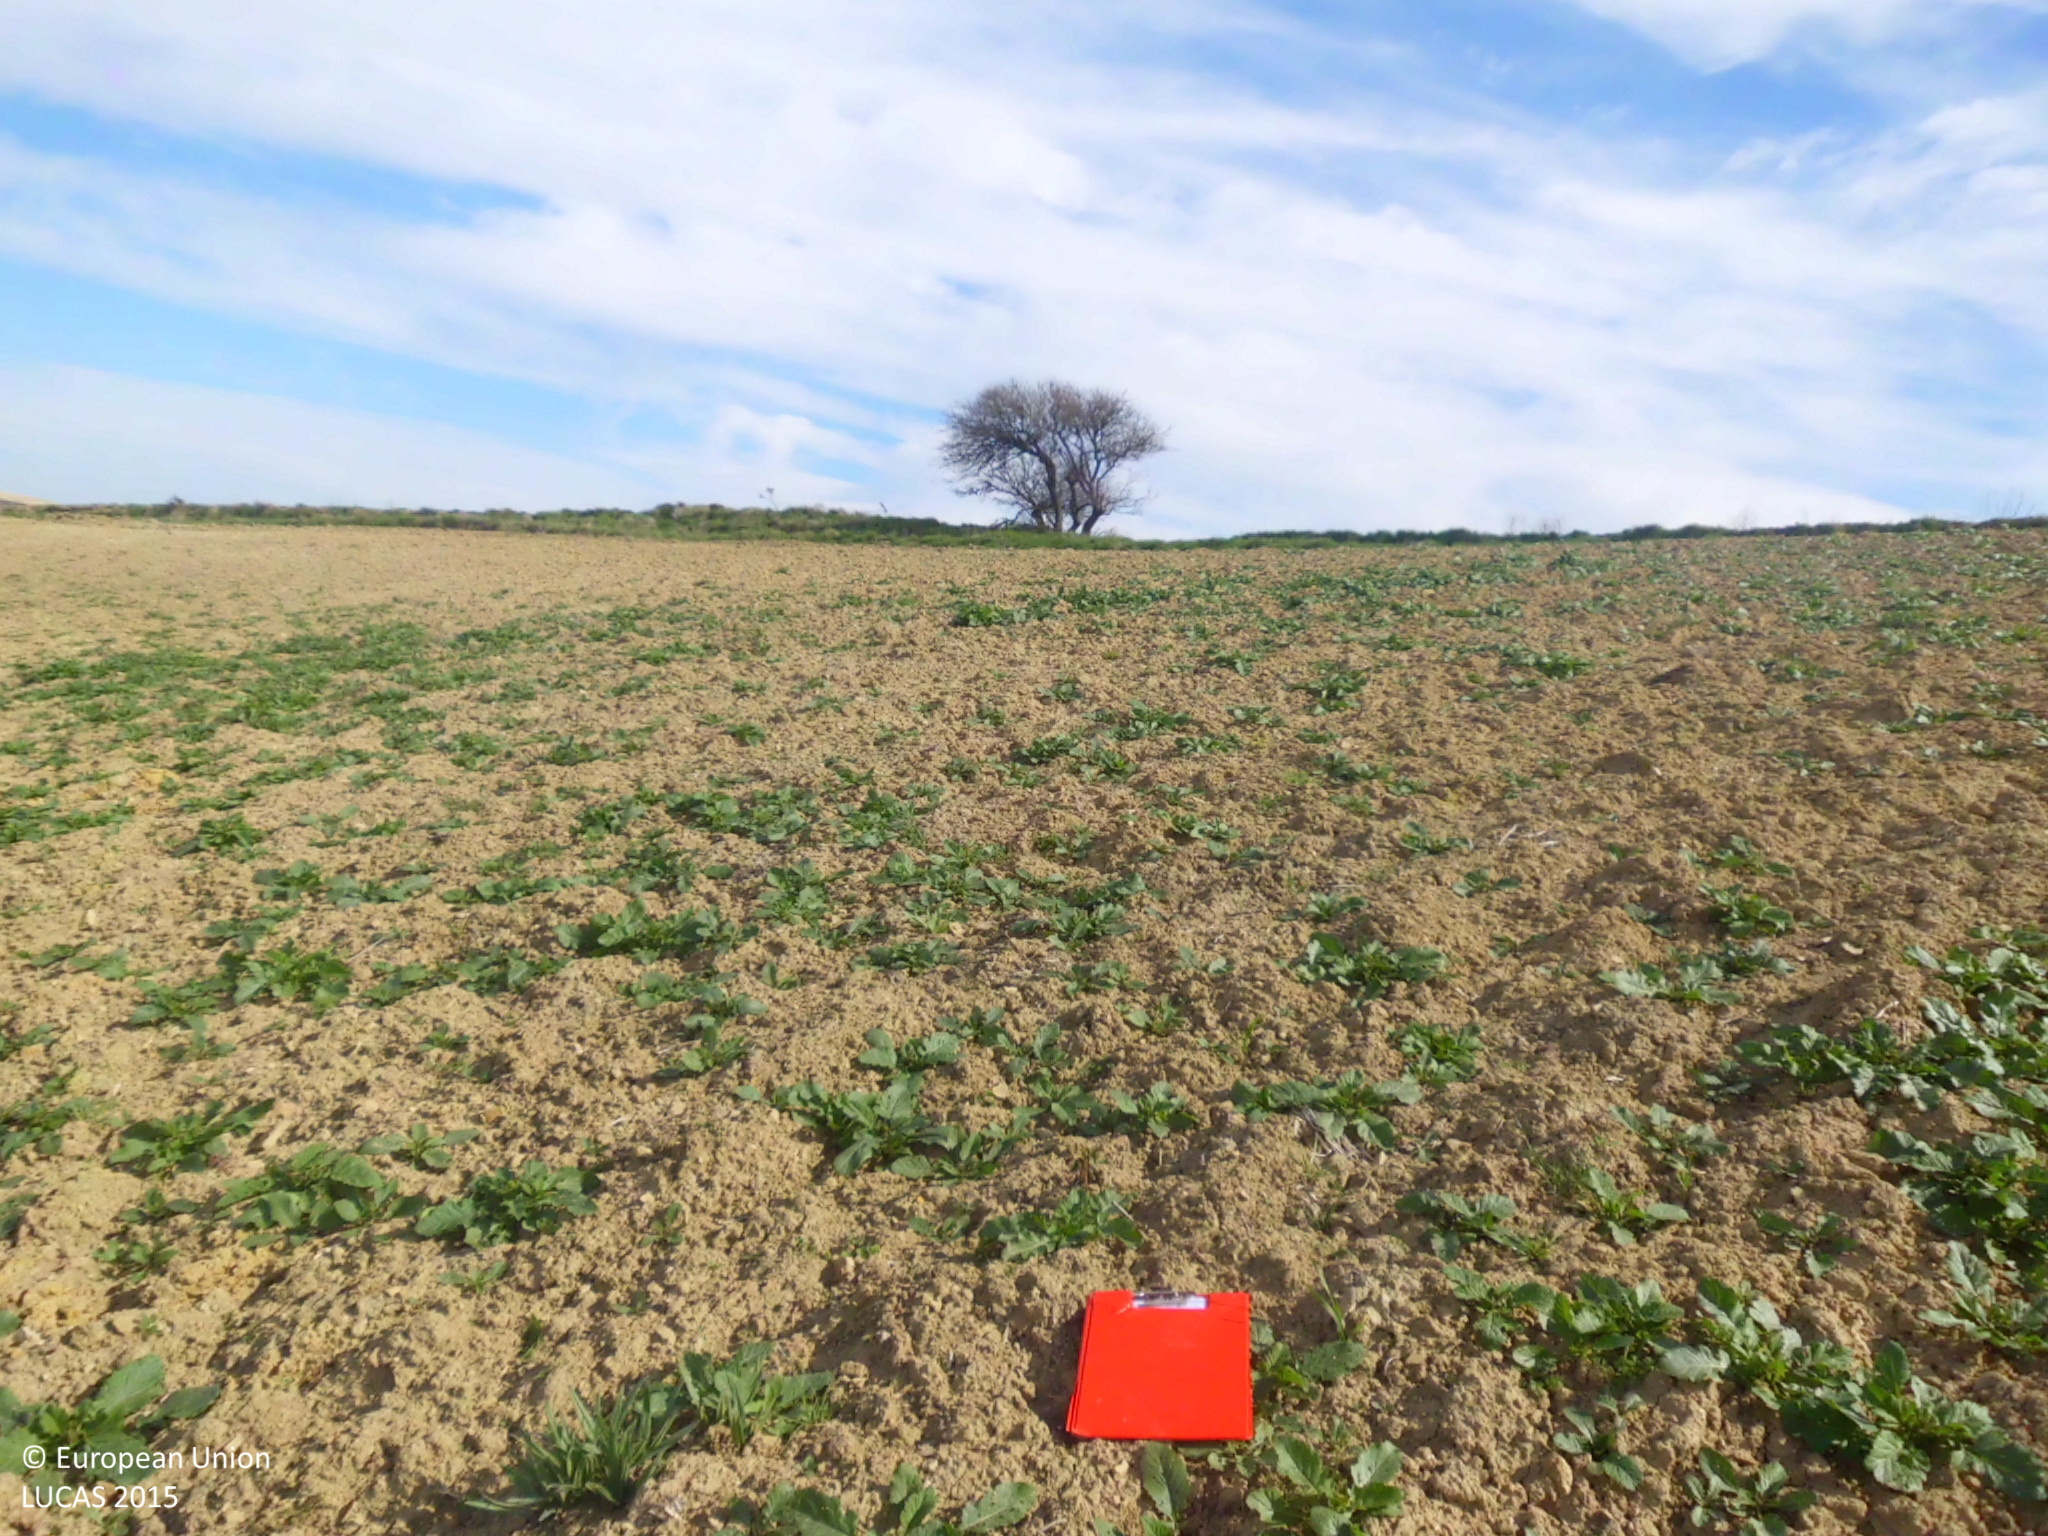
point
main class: Grassland
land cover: Spontaneously vegetated surfaces
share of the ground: 10 - 25 %
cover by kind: unconsolidated bare surface 85 %, herbaceous plants 15 %
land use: Fallow land
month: April
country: ES
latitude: 42.4156
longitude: -3.4123
